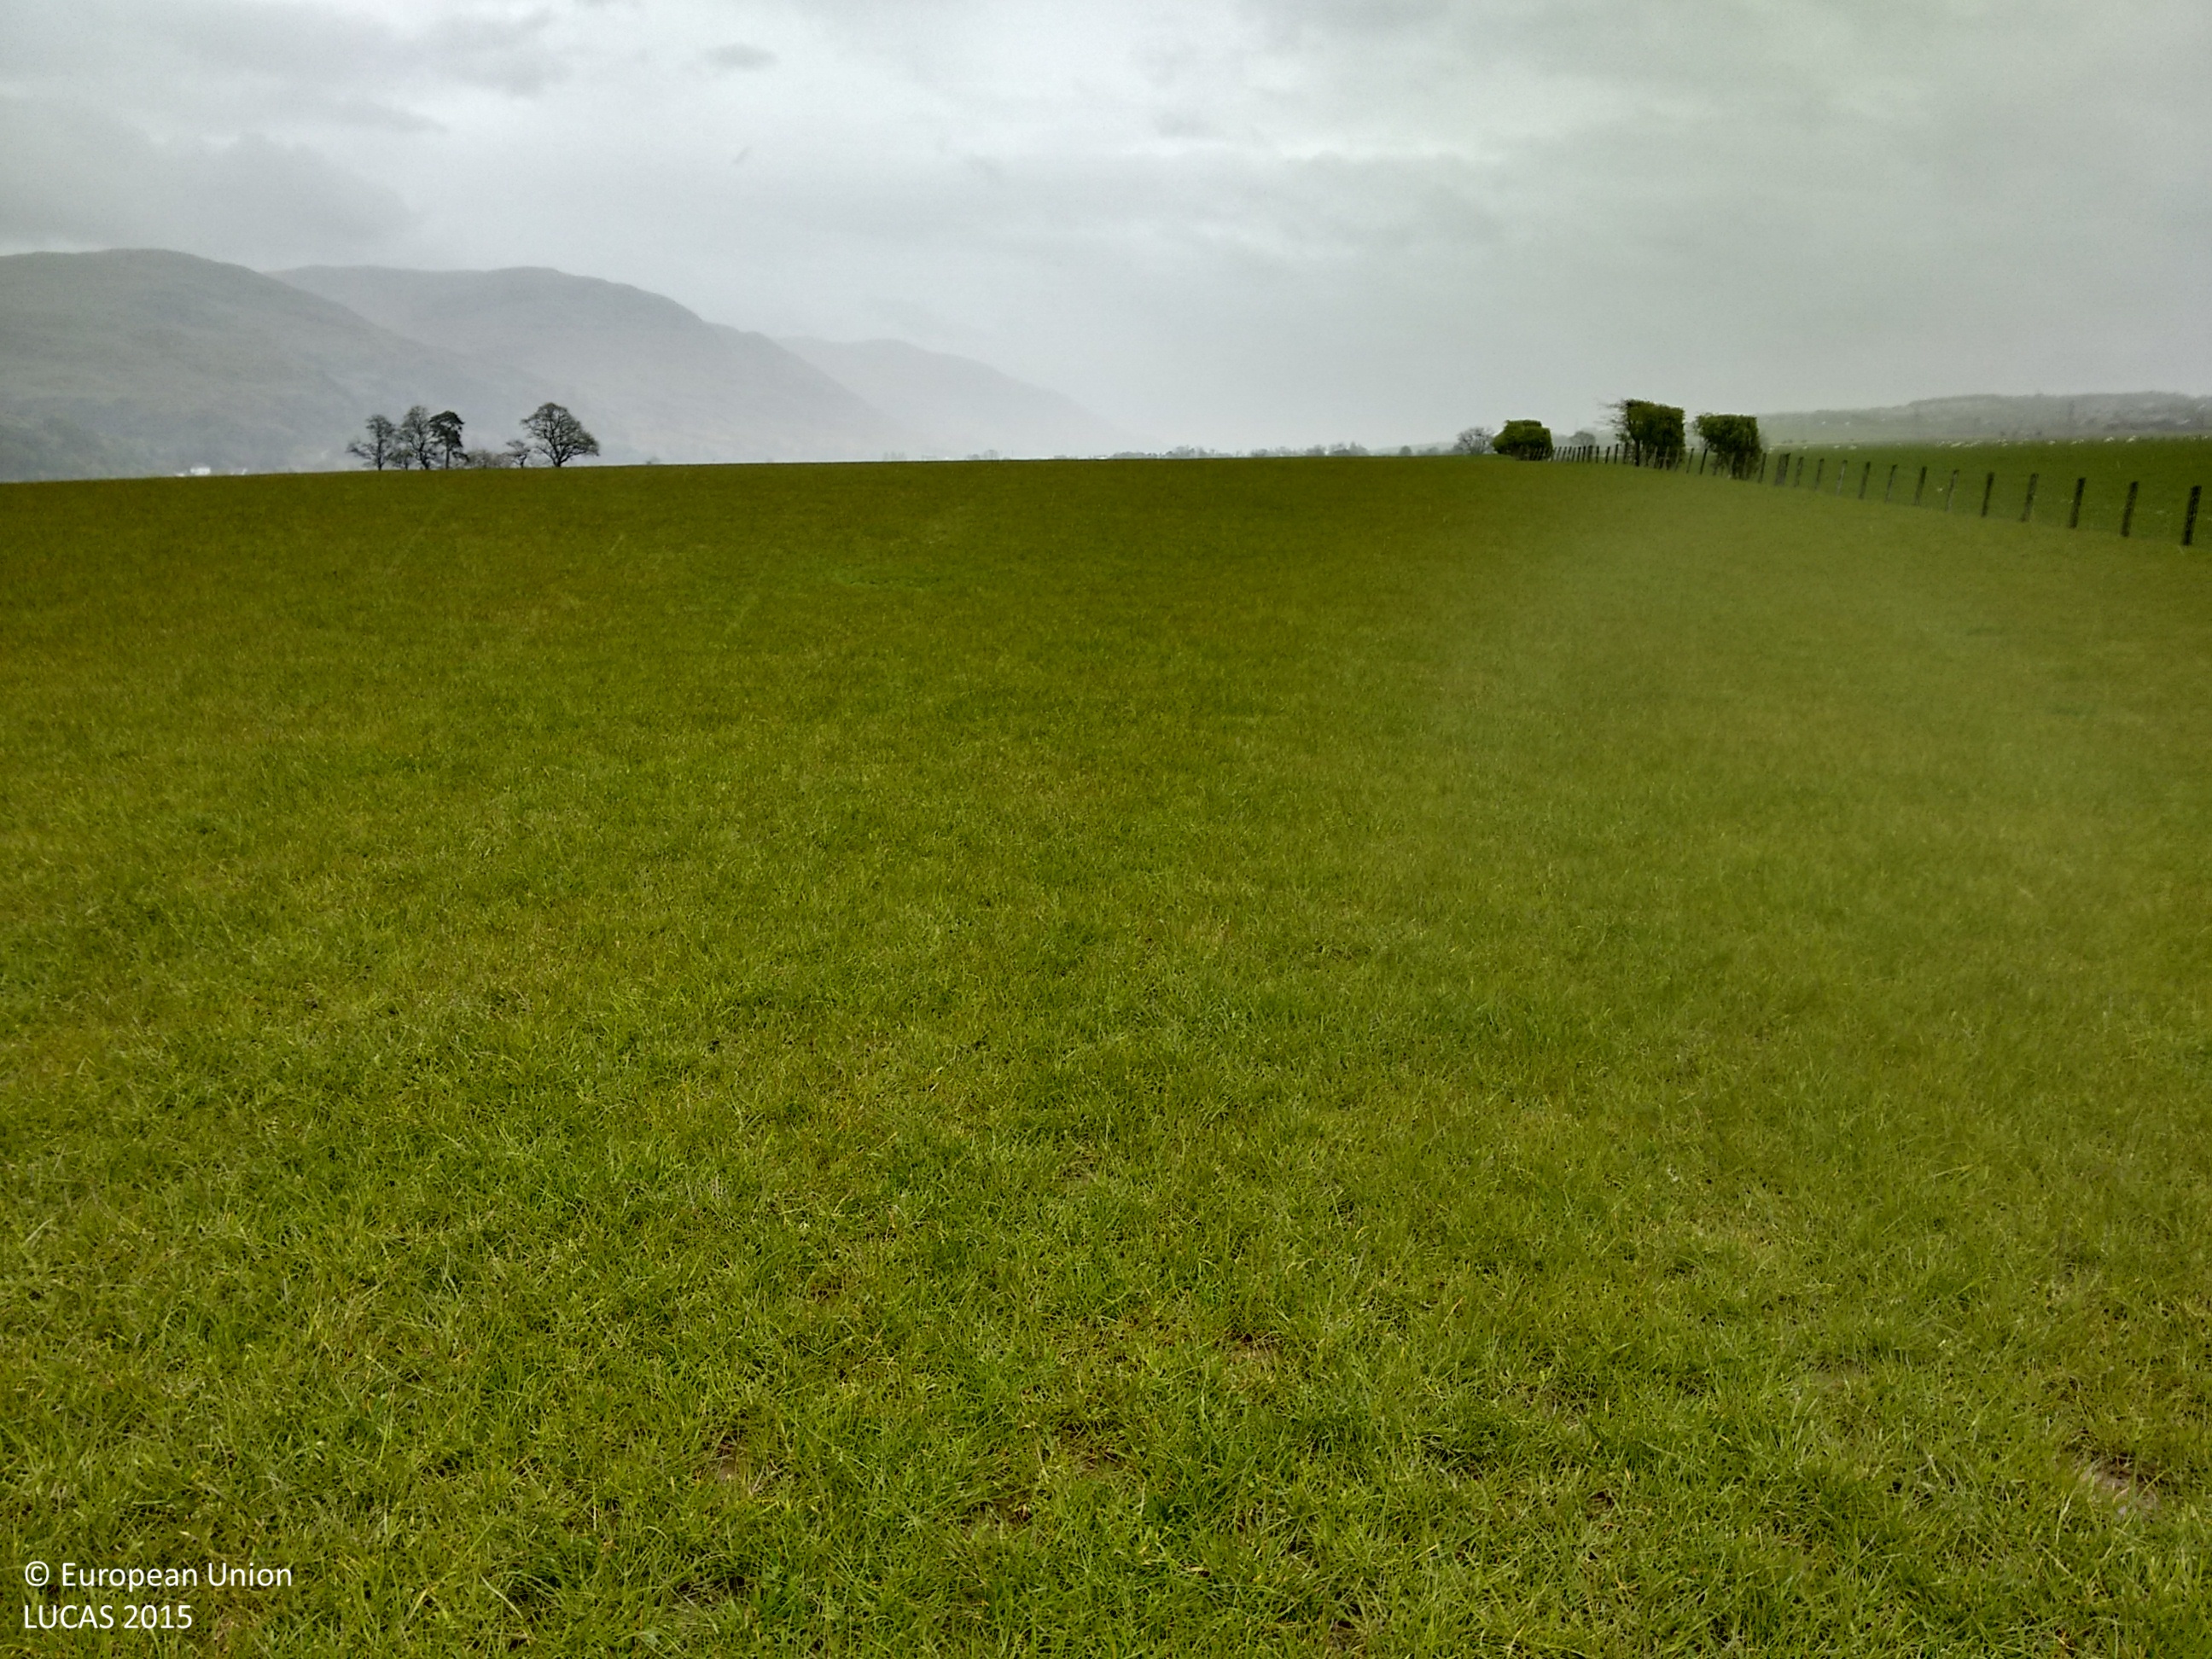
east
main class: Grassland
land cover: Grassland without tree/shrub cover
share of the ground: > 75 %
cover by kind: herbaceous plants 100 %
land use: Agriculture (excluding fallow land and kitchen gardens)
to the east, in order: Grassland without tree/shrub cover; Fences; Managed hedges; Grassland without tree/shrub cover
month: May
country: GB
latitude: 56.1416
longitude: -3.8764
